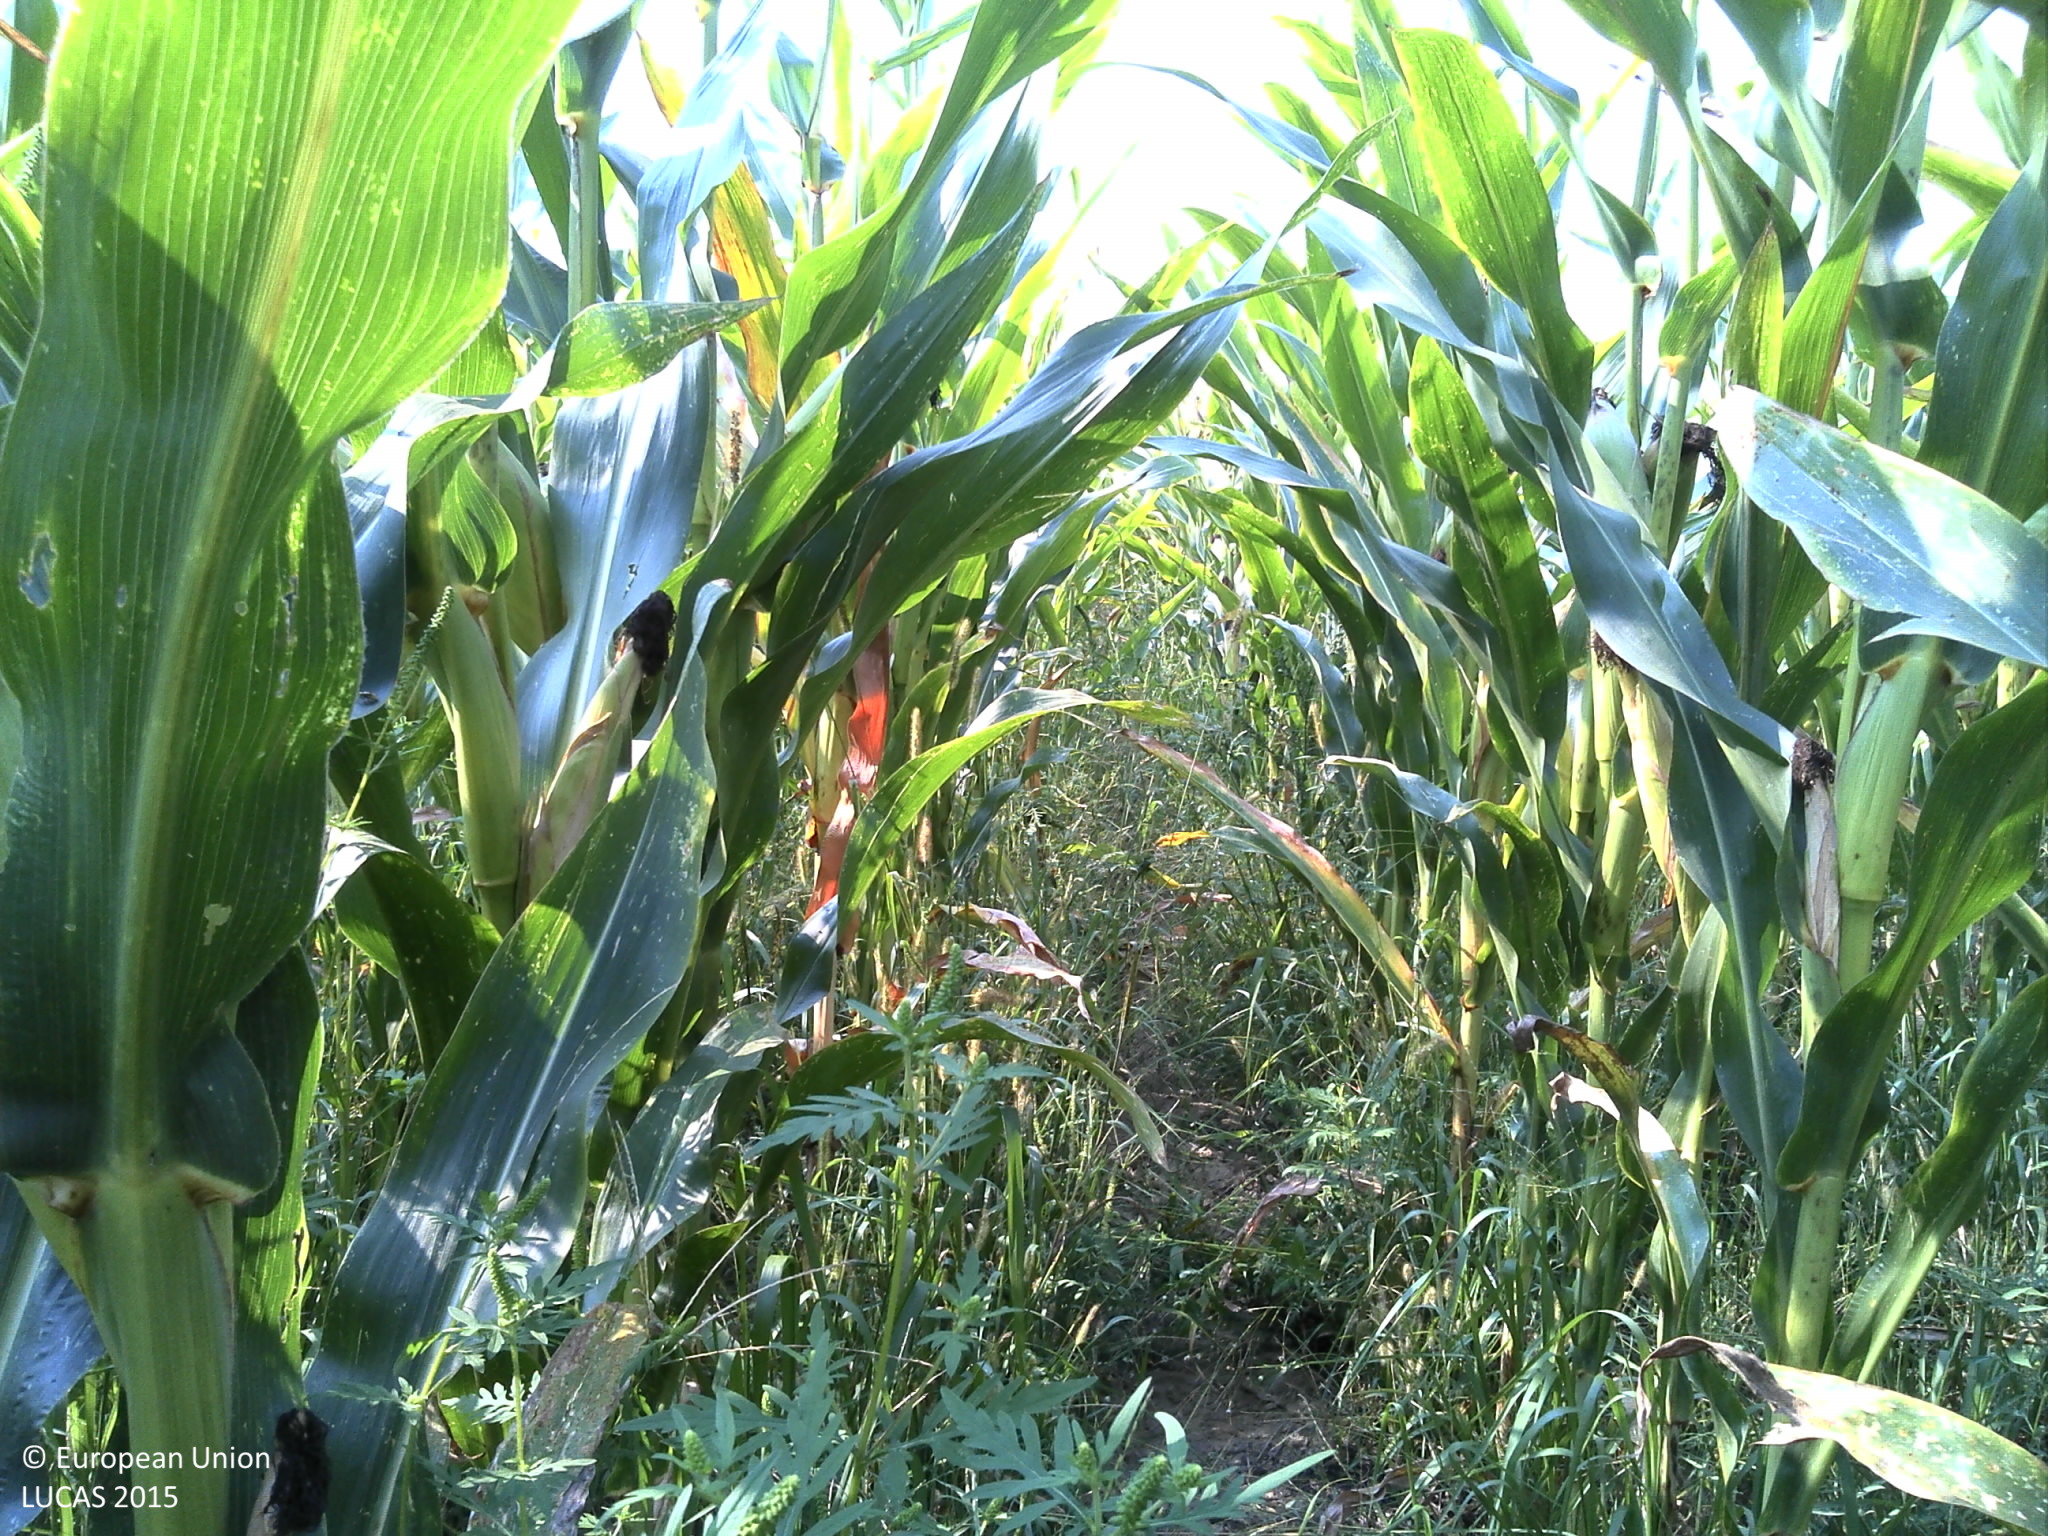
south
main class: Cropland
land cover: Maize
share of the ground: > 75 %
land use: Agriculture (excluding fallow land and kitchen gardens)
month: August
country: HR
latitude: 45.8357
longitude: 17.4826
